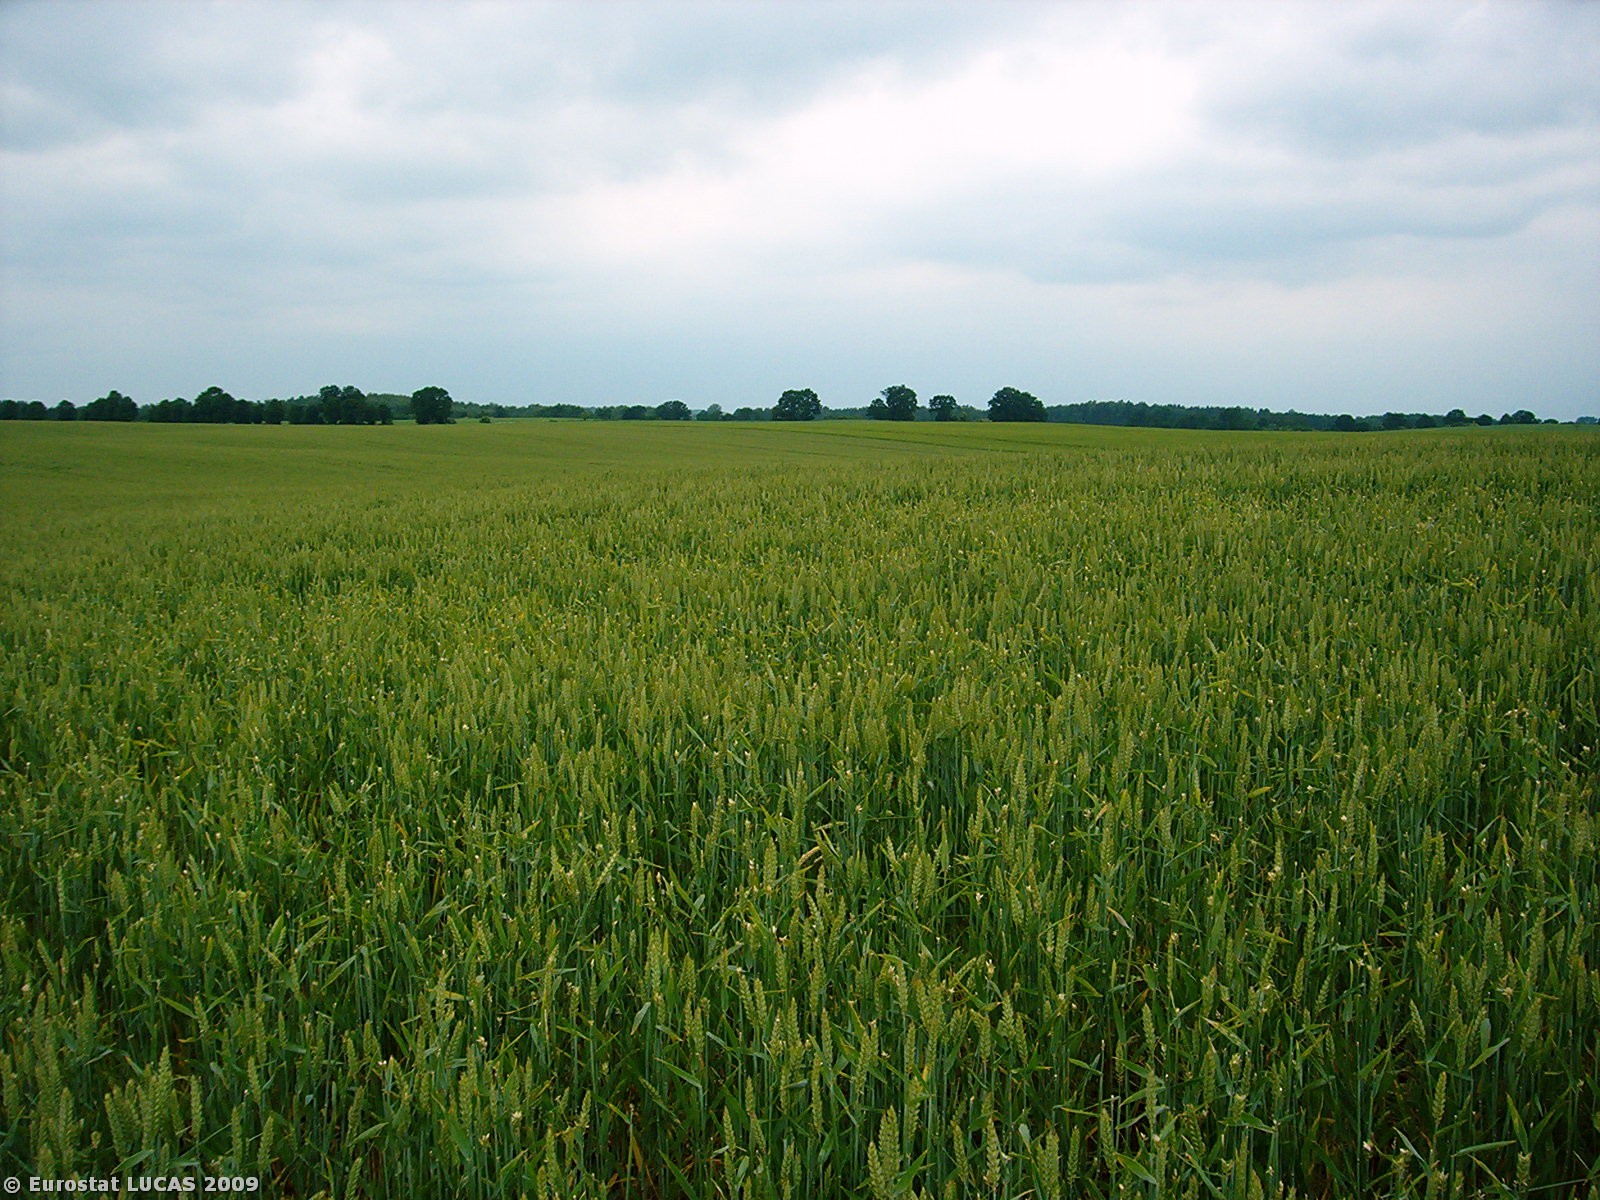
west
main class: Cropland
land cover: Common wheat
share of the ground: > 75 %
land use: Agriculture (excluding fallow land and kitchen gardens)
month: June
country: PL
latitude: 53.0273
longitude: 15.4456
